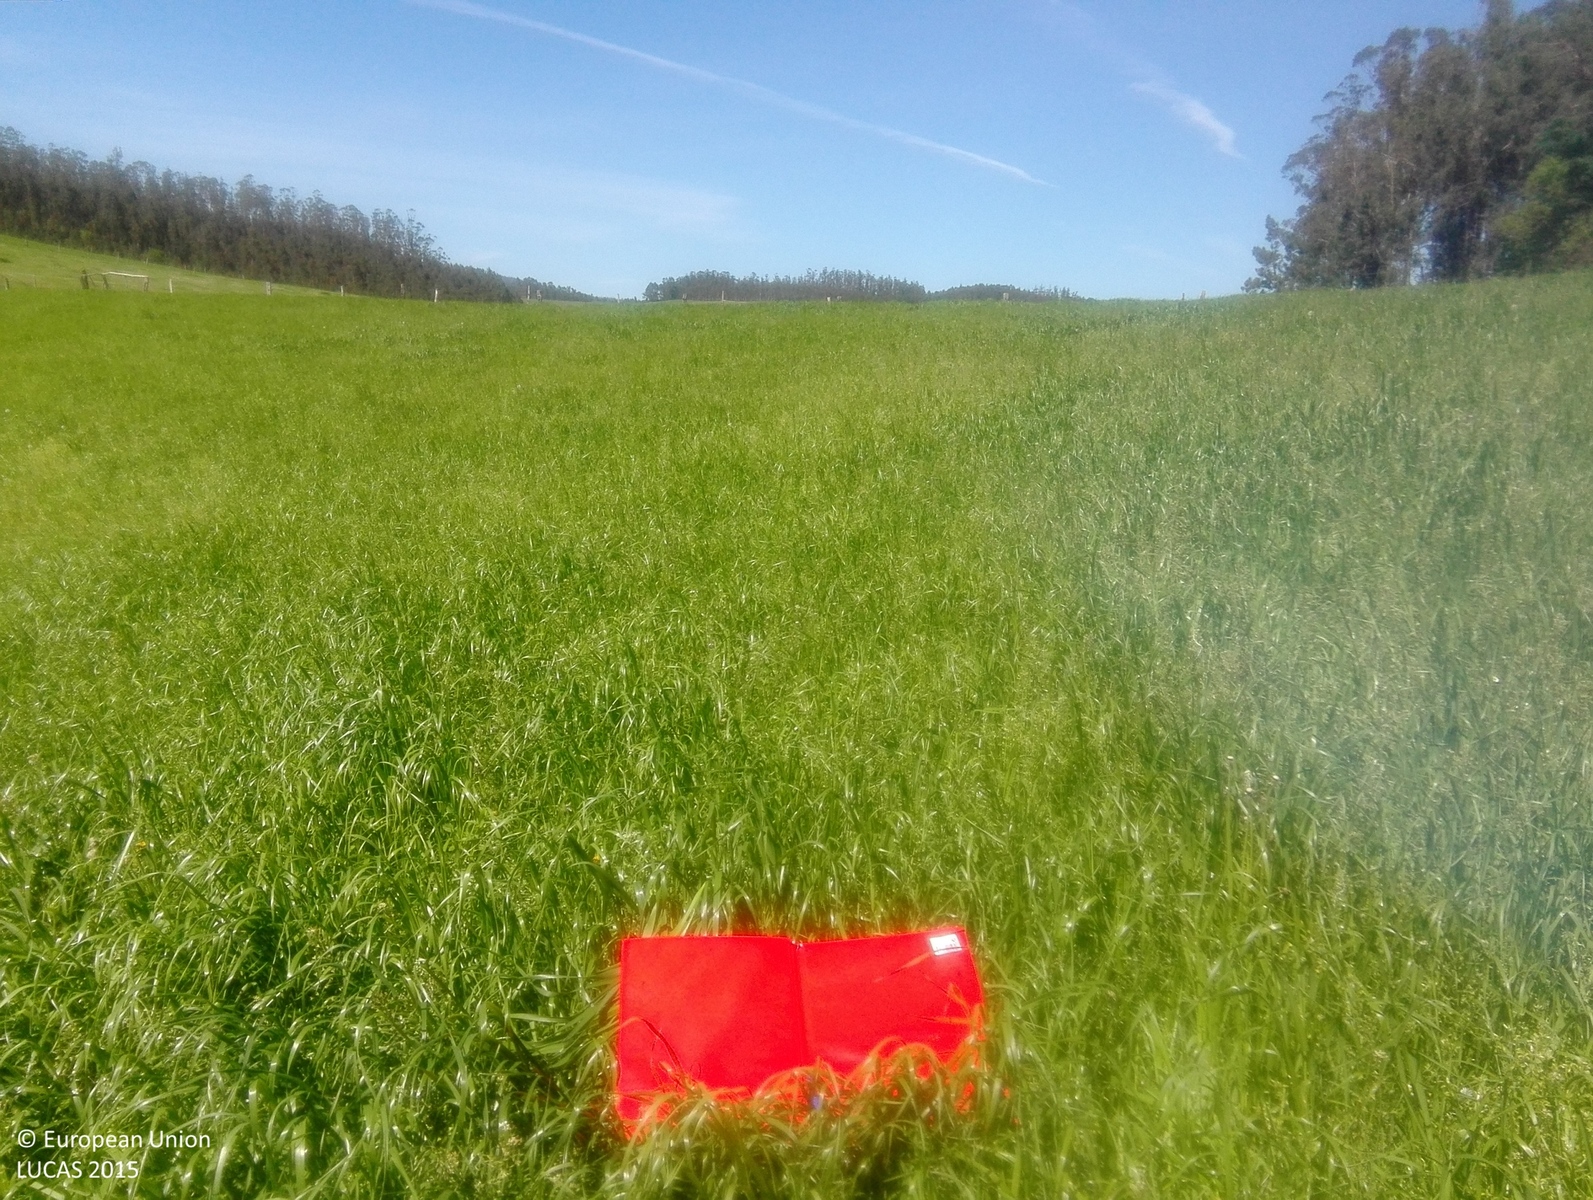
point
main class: Cropland
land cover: Temporary grasslands
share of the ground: > 75 %
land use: Agriculture (excluding fallow land and kitchen gardens)
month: April
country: ES
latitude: 43.4759
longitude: -7.0680
